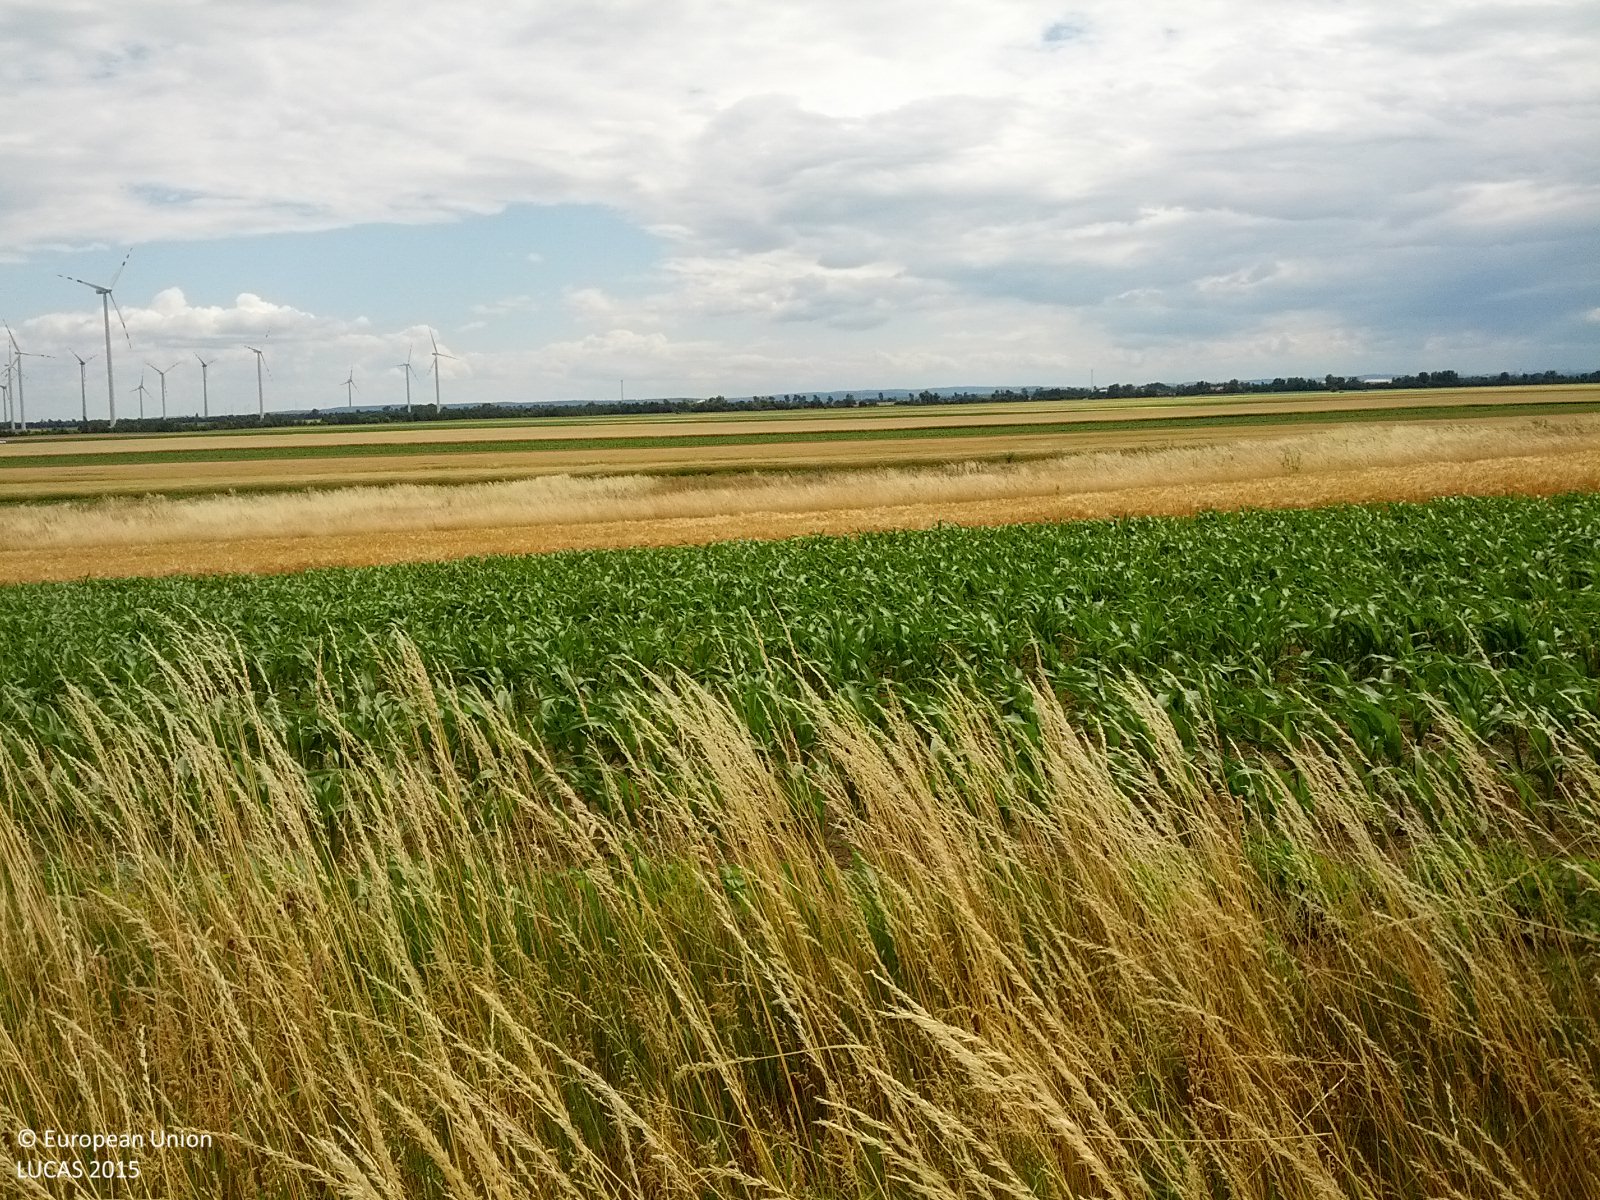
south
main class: Grassland
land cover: Grassland without tree/shrub cover
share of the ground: > 75 %
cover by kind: herbaceous plants 100 %
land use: Agriculture (excluding fallow land and kitchen gardens)
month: June
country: AT
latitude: 48.2755
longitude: 16.6490
